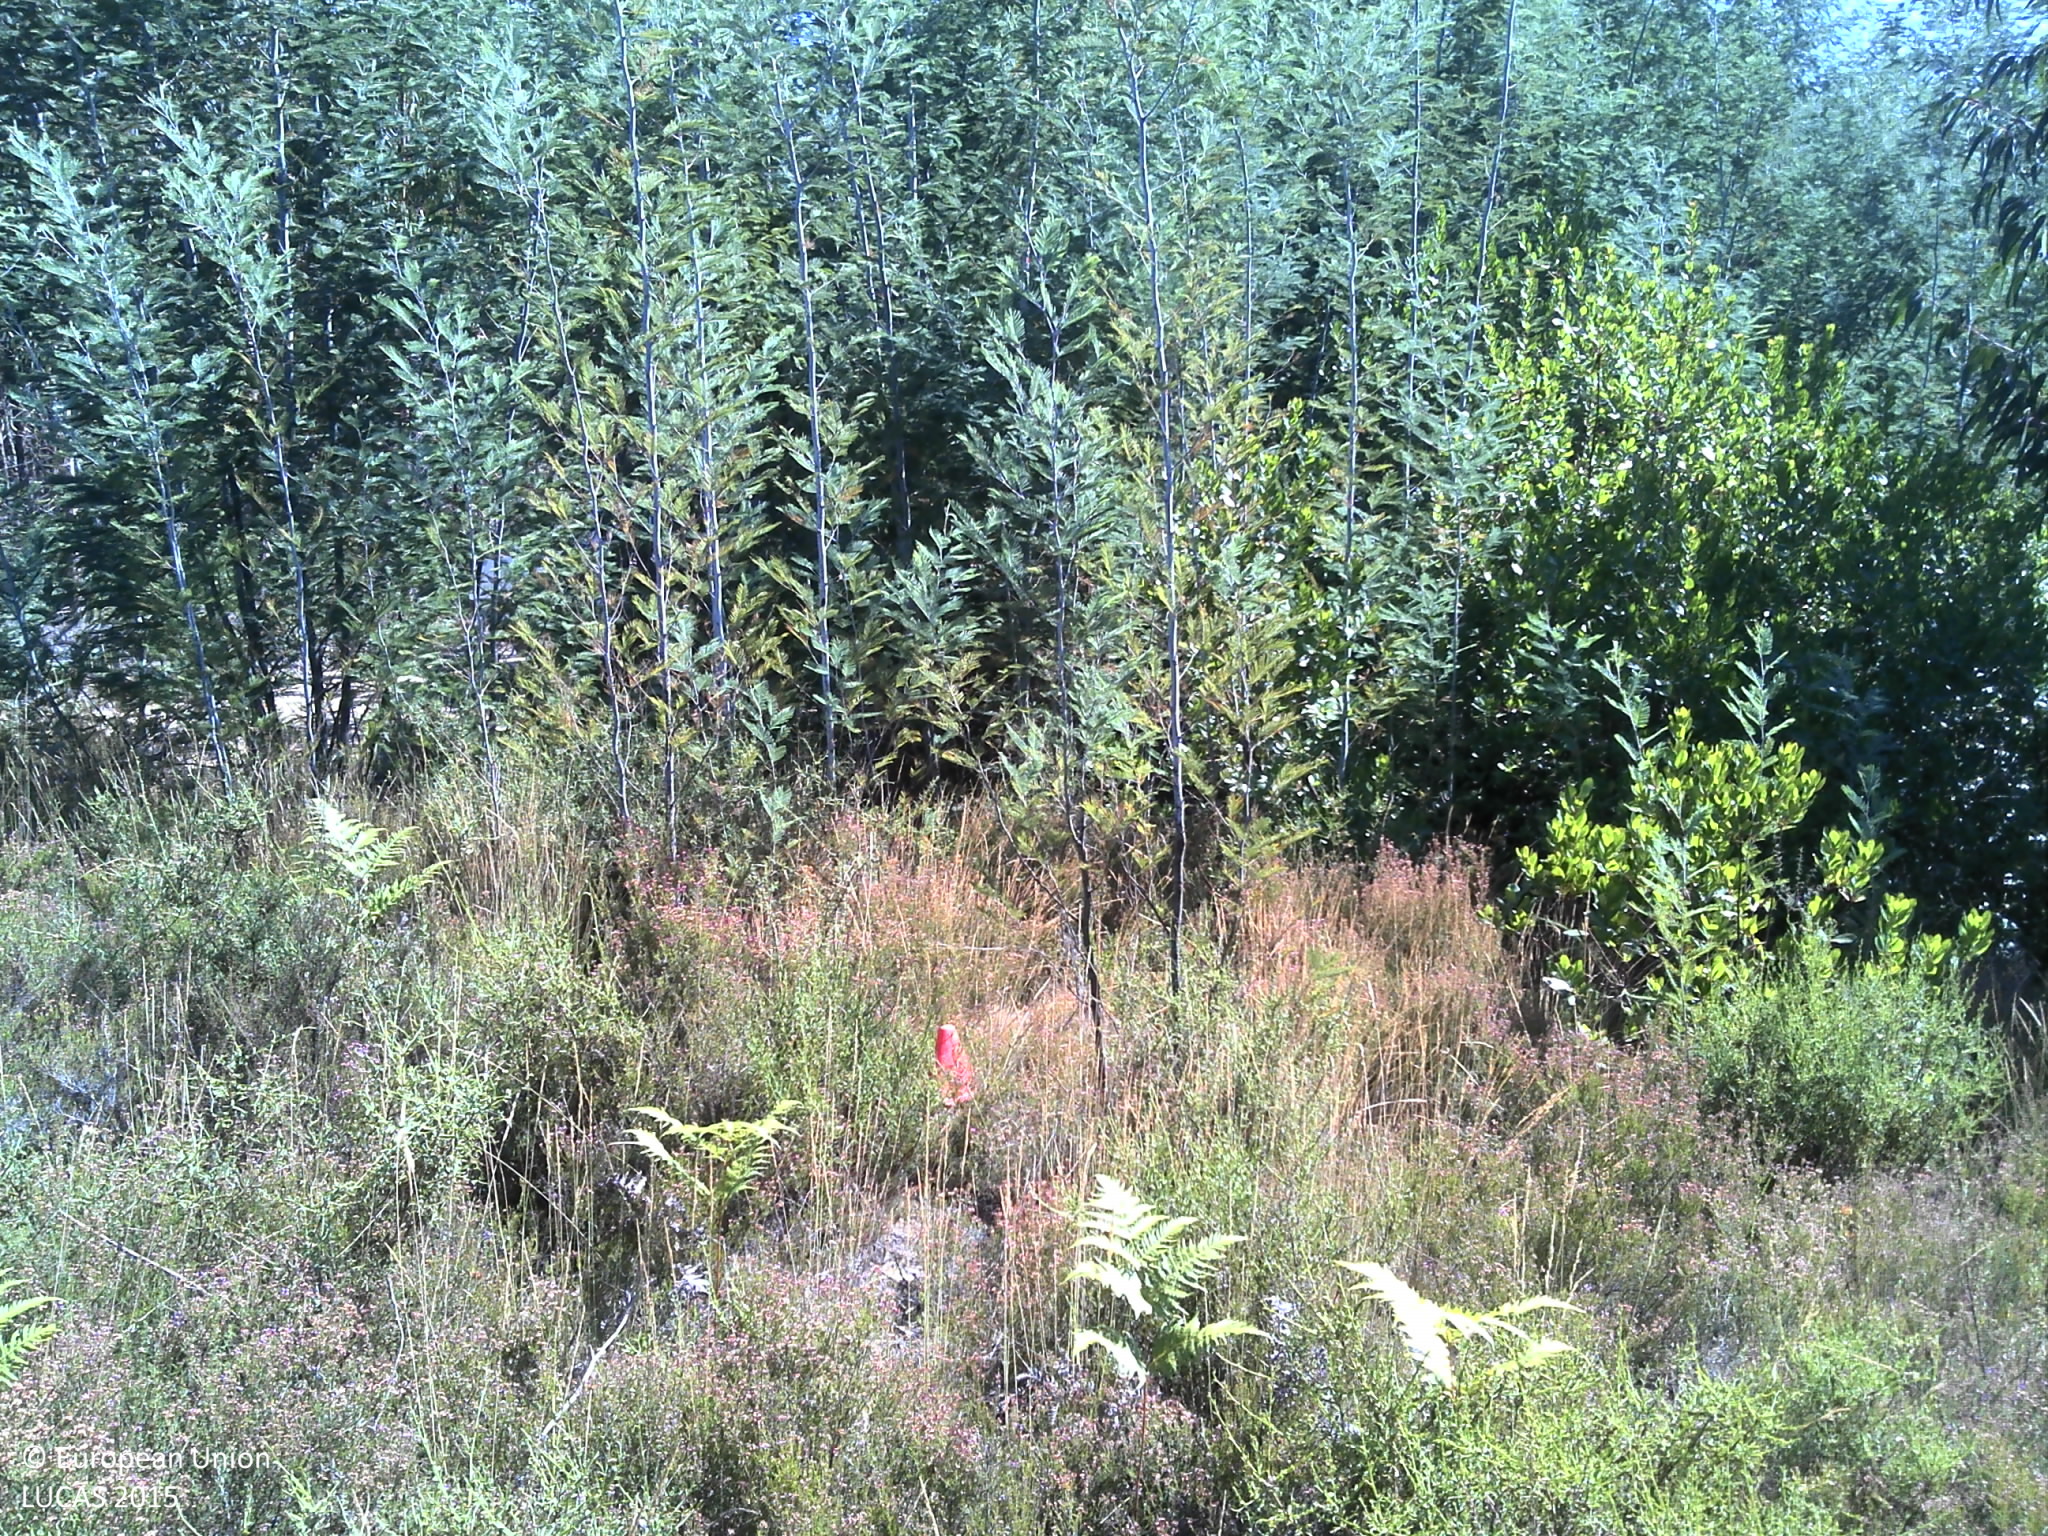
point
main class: Shrubland
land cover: Shrubland with sparse tree cover
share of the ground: > 75 %
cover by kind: shrubs 90 %, broadleaved forest trees 5 %, herbaceous plants 5 %
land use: Semi-natural and natural areas not in use
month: June
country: PT
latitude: 40.1676
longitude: -8.2426
